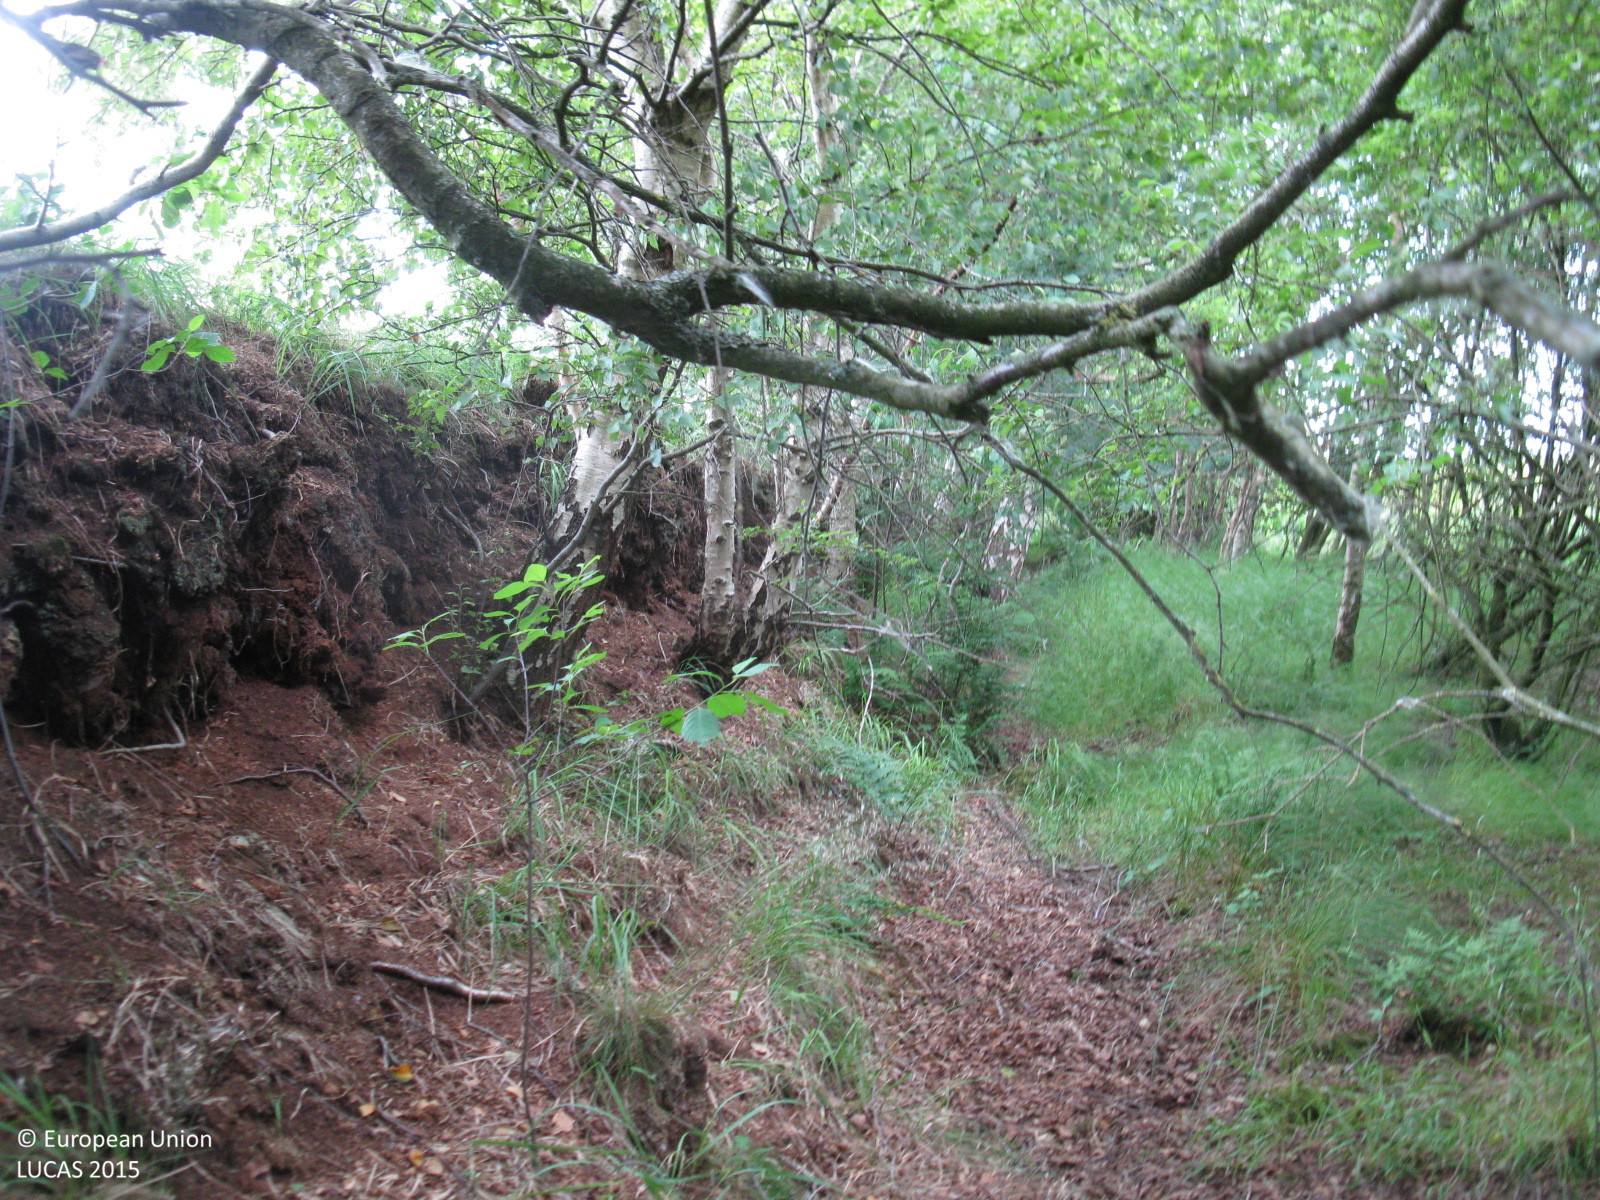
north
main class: Woodland
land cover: Broadleaved woodland
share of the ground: > 75 %
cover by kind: broadleaved forest trees 100 %
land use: Semi-natural and natural areas not in use
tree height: > 5 m
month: July
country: DE
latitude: 53.3475
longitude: 7.8826
